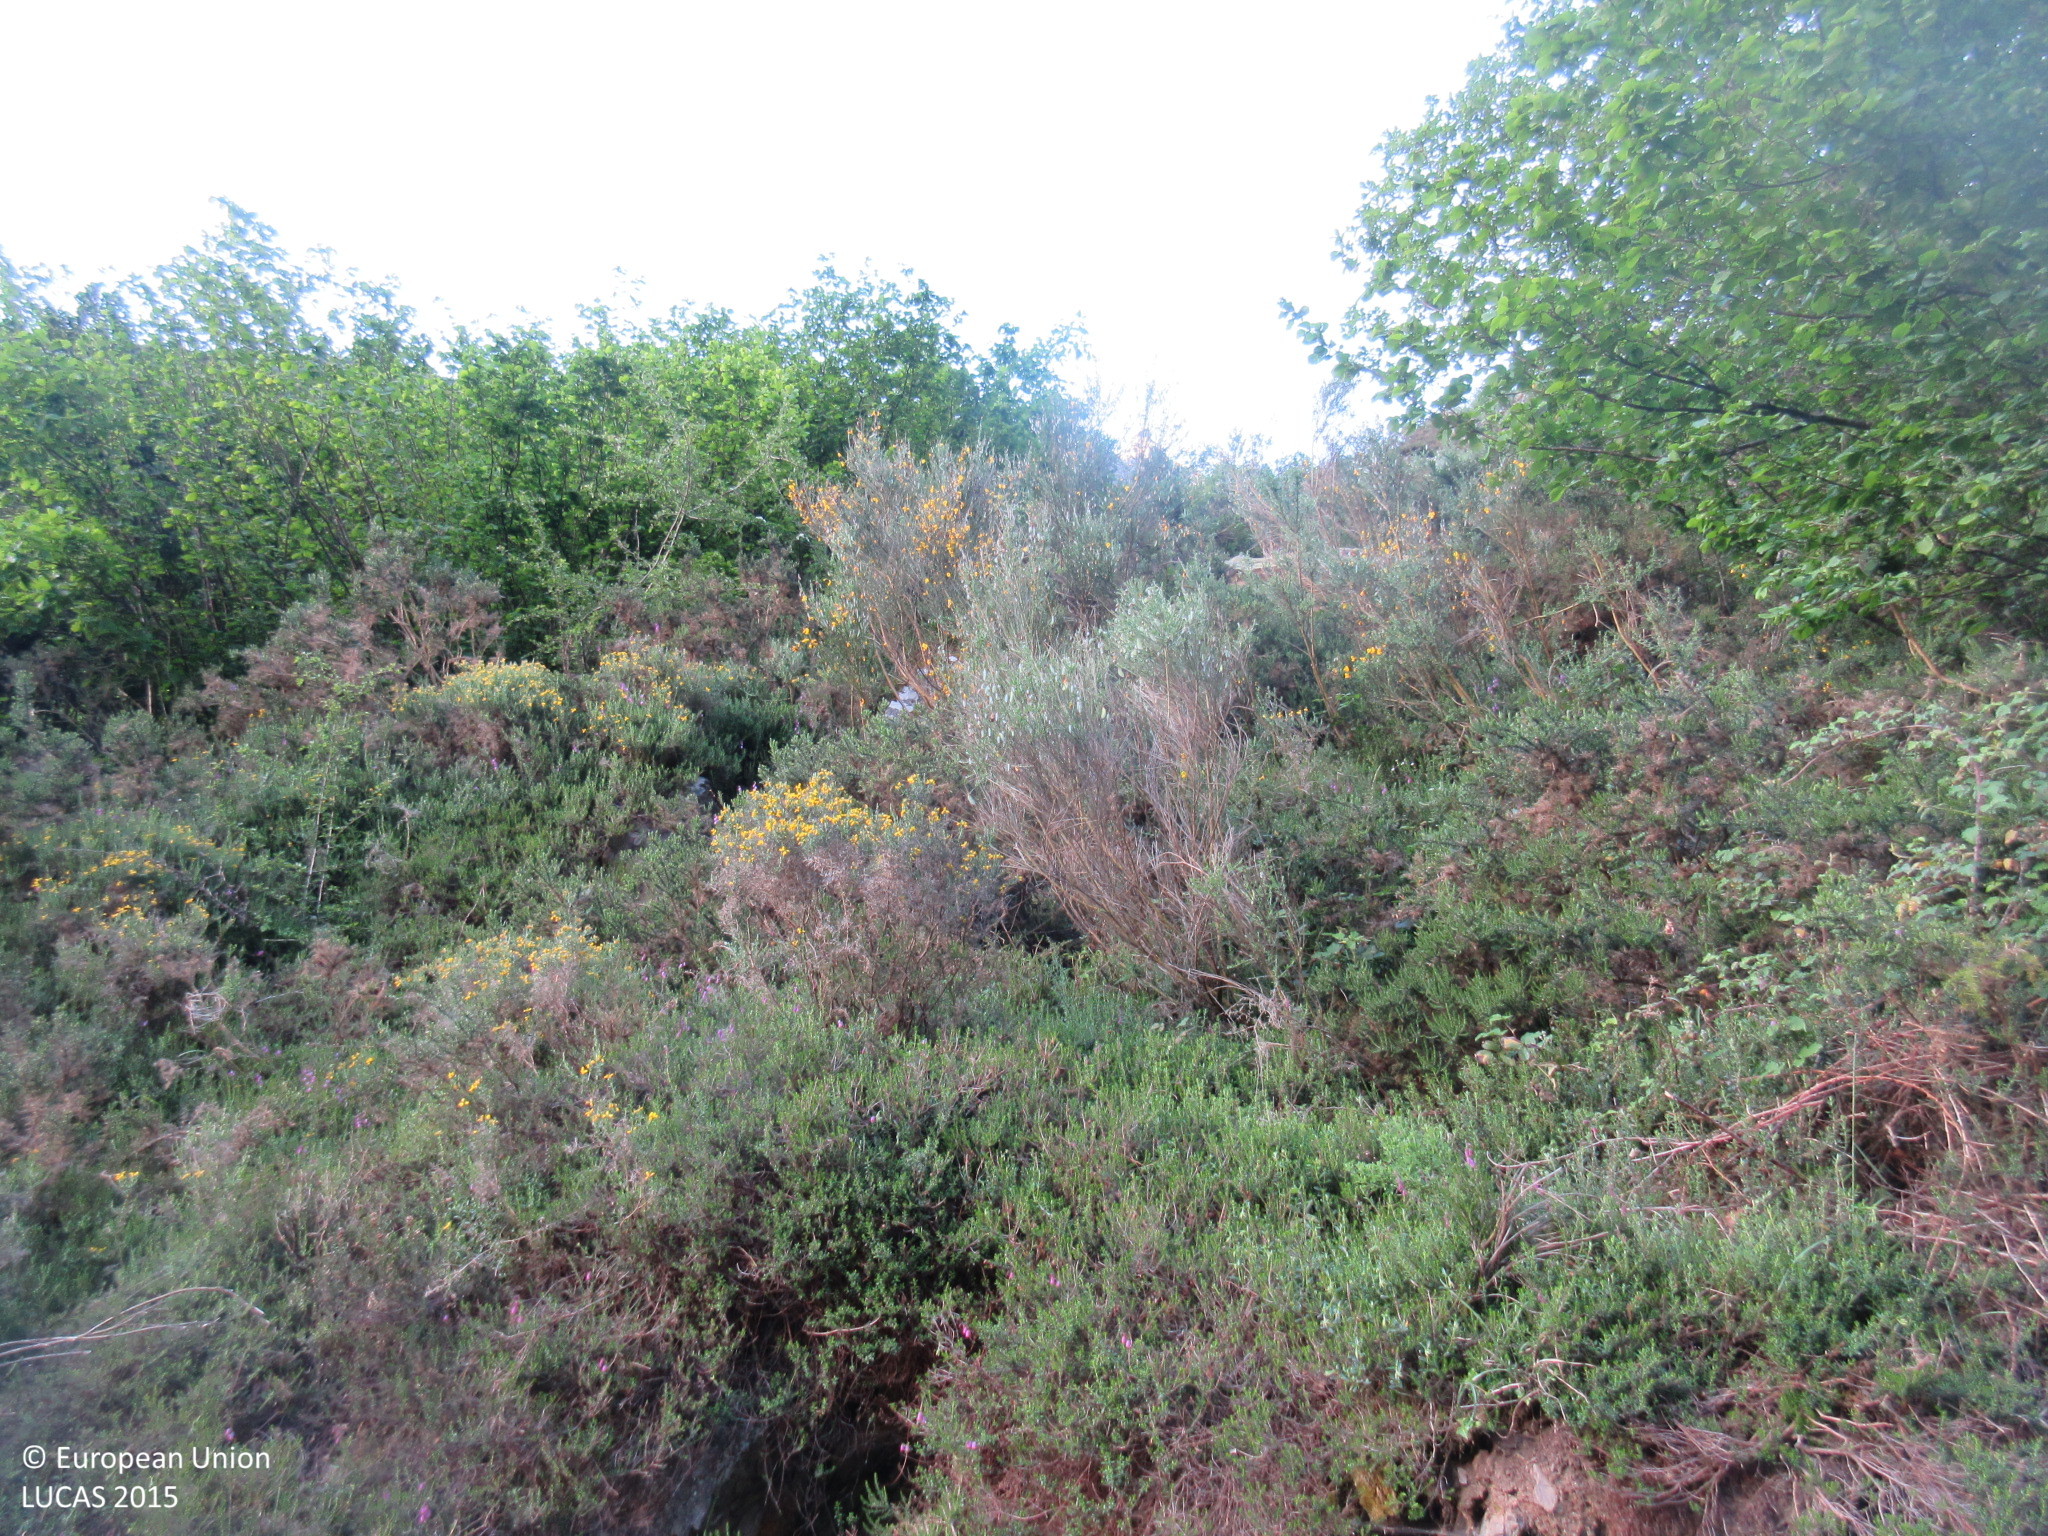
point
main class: Shrubland
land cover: Shrubland with sparse tree cover
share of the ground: > 75 %
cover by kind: shrubs 95 %, broadleaved forest trees 5 %
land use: Semi-natural and natural areas not in use
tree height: > 5 m
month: May
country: ES
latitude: 43.0830
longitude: -5.5174
